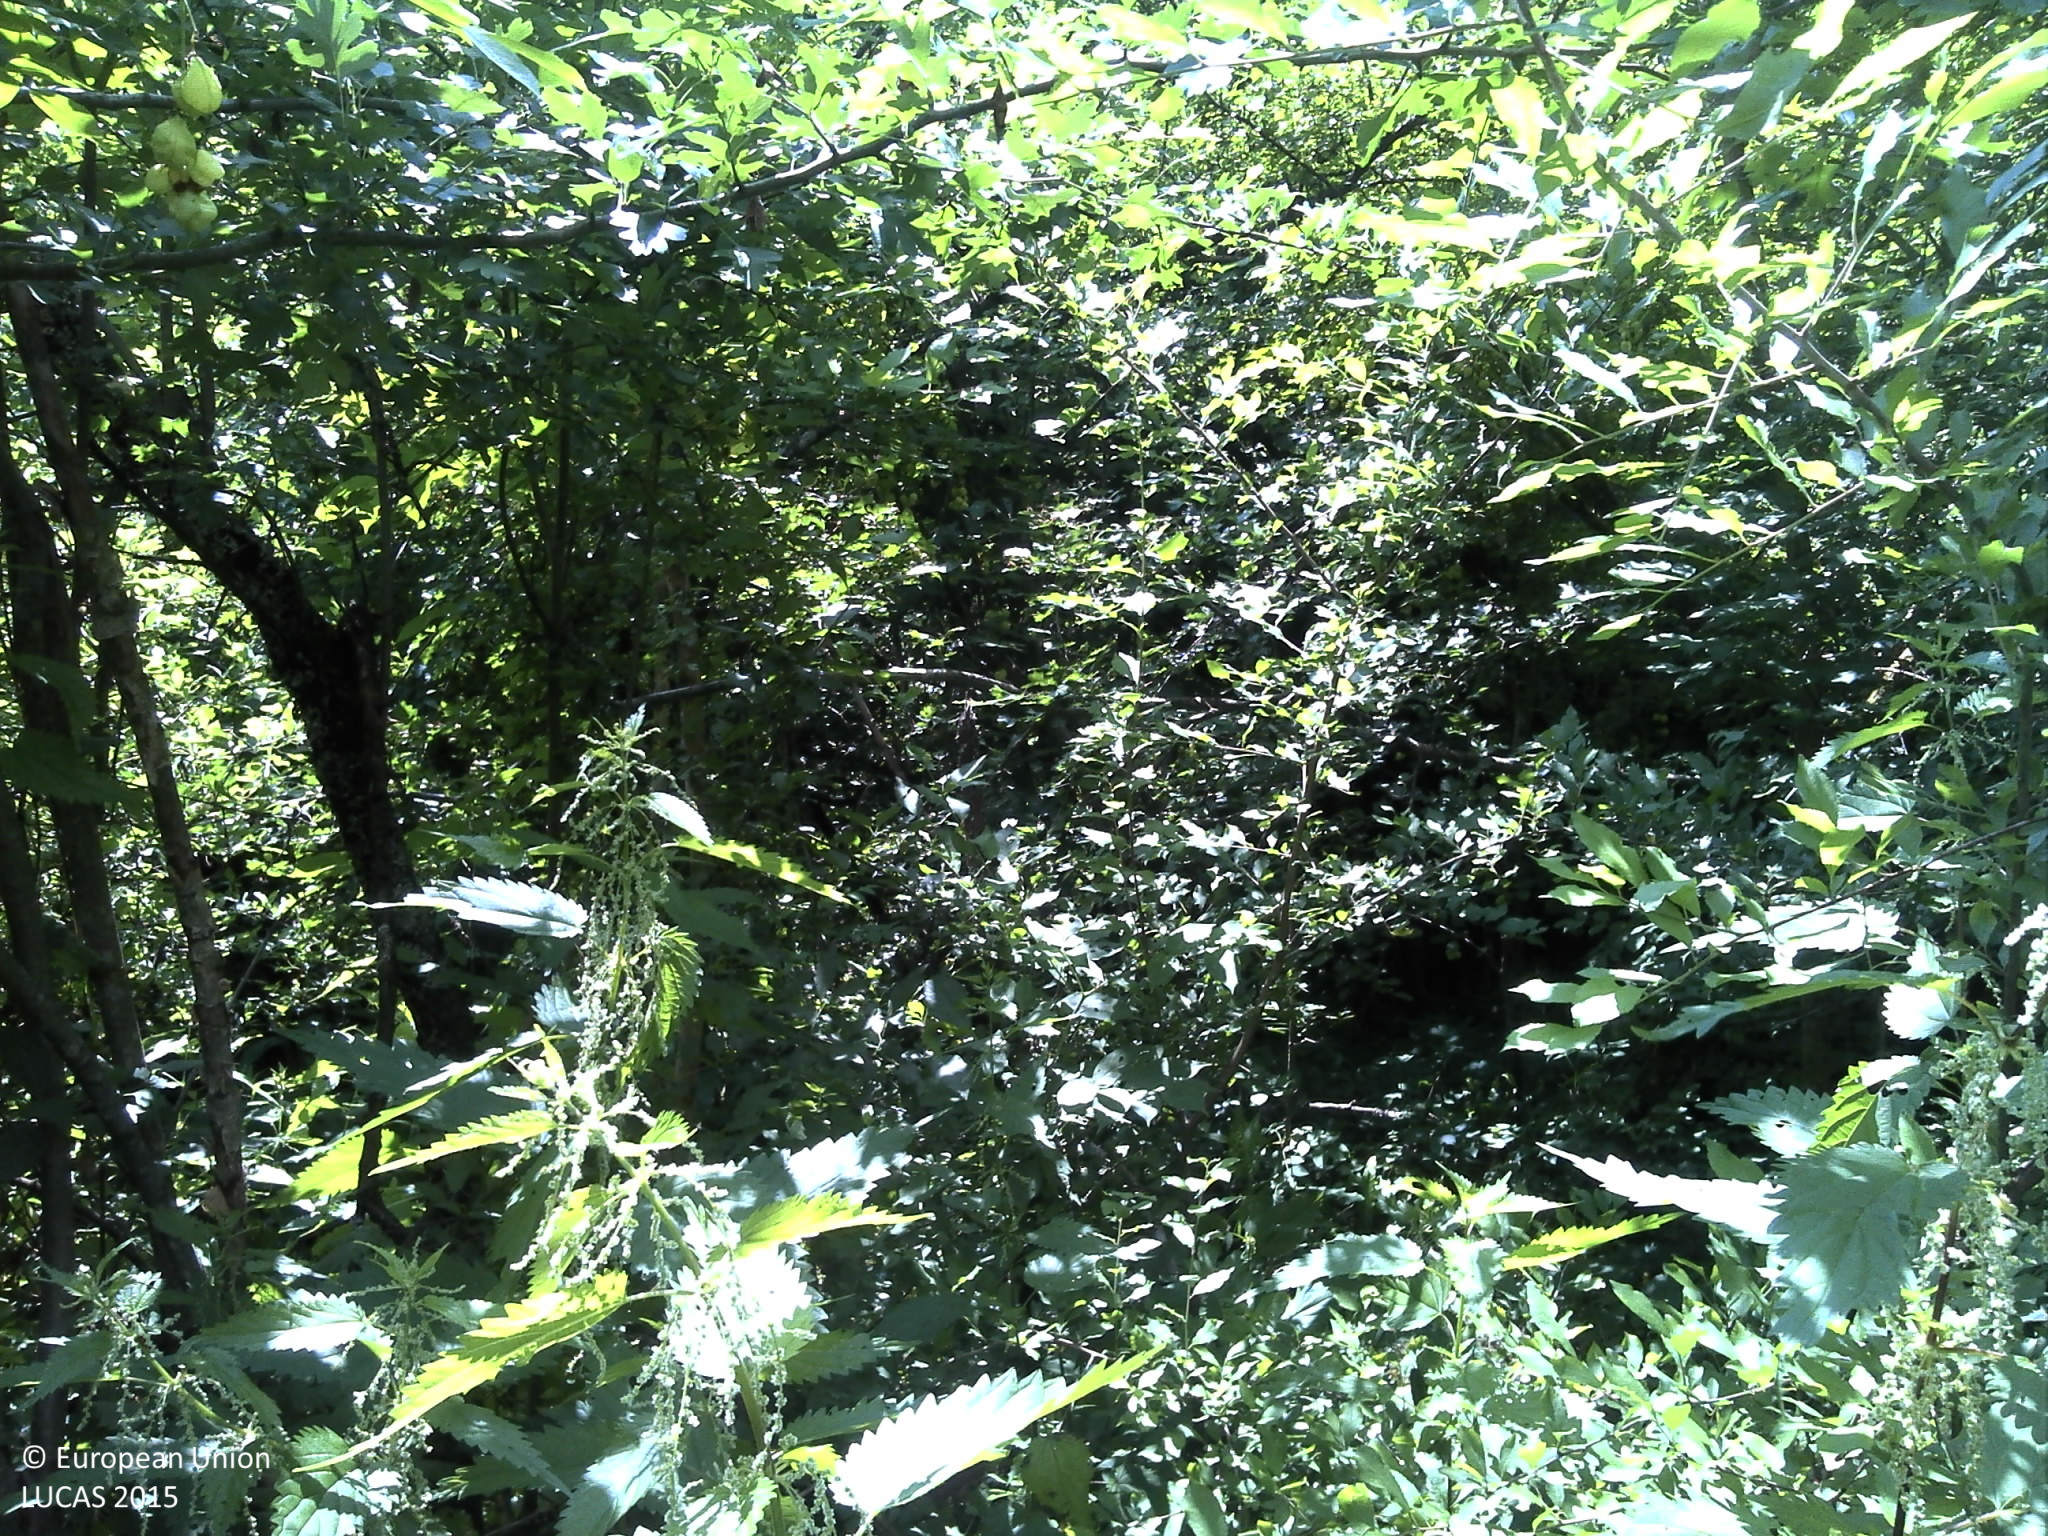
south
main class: Woodland
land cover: Broadleaved woodland
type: beech forest
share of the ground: > 75 %
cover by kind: broadleaved forest trees 75 %, shrubs 25 %
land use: Forestry
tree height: > 5 m
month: June
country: HR
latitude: 44.8459
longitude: 15.6753
